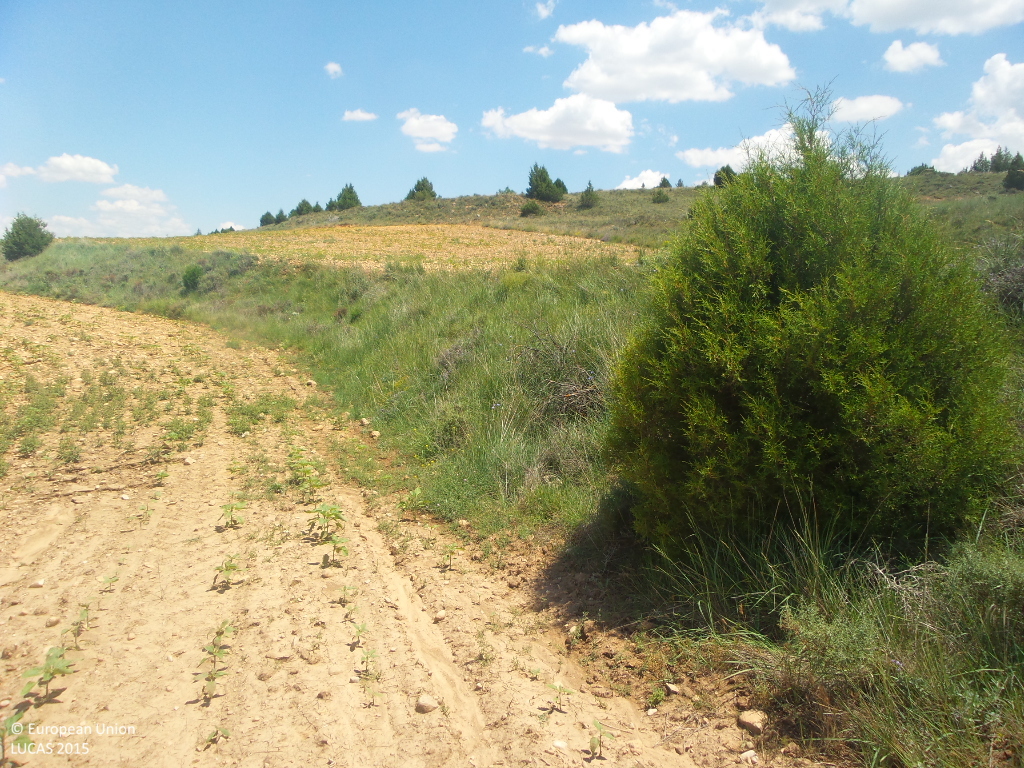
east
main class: Cropland
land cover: Sunflower
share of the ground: 10 - 25 %
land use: Agriculture (excluding fallow land and kitchen gardens)
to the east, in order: Sunflower; Shrubland without tree cover; Sunflower; Shrubland with sparse tree cover; Shrubland without tree cover; Shrubland with sparse tree cover; Other bare soil
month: June
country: ES
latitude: 41.4610
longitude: -3.0314
